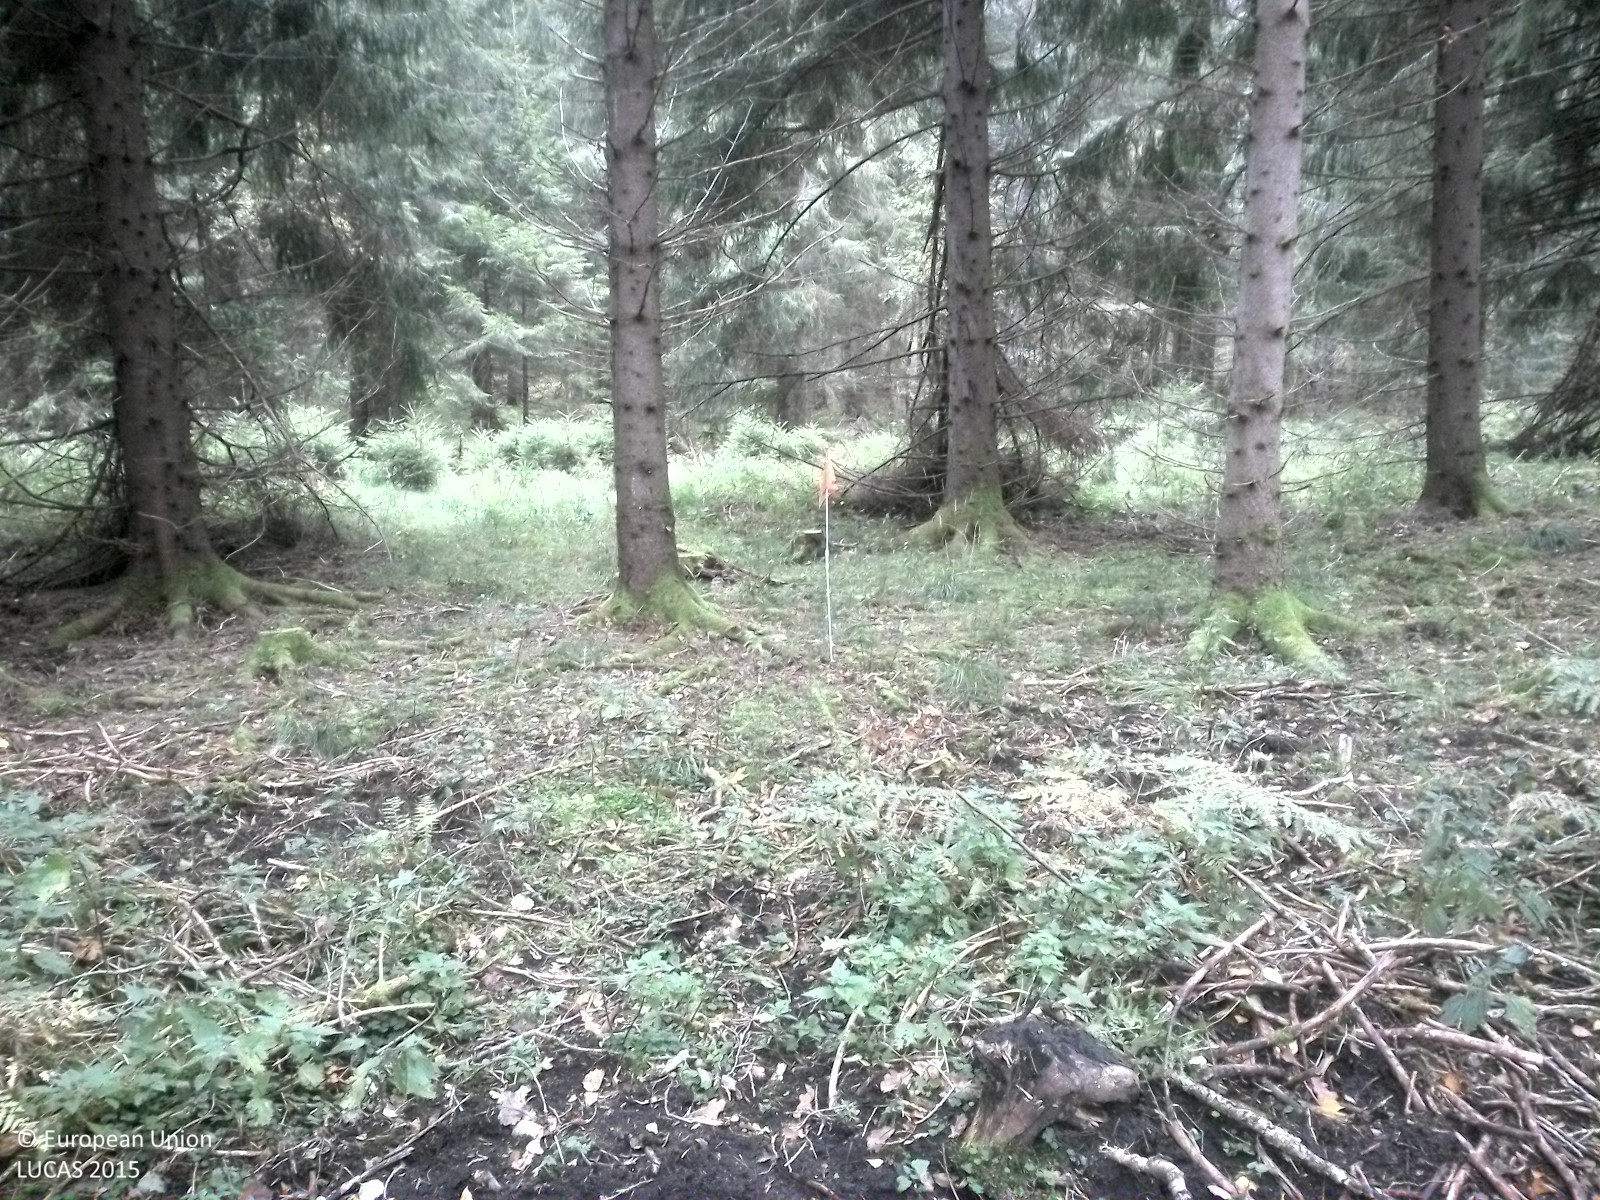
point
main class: Woodland
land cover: Spruce dominated coniferous woodland
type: boreal forest
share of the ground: 50 - 75 %
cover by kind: coniferous forest trees 60 %, lichens and mosses 20 %, herbaceous plants 10 %, unconsolidated bare surface 10 %
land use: Forestry
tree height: > 5 m
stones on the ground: < 10 %
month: September
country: SE
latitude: 58.9073
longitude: 15.7744
